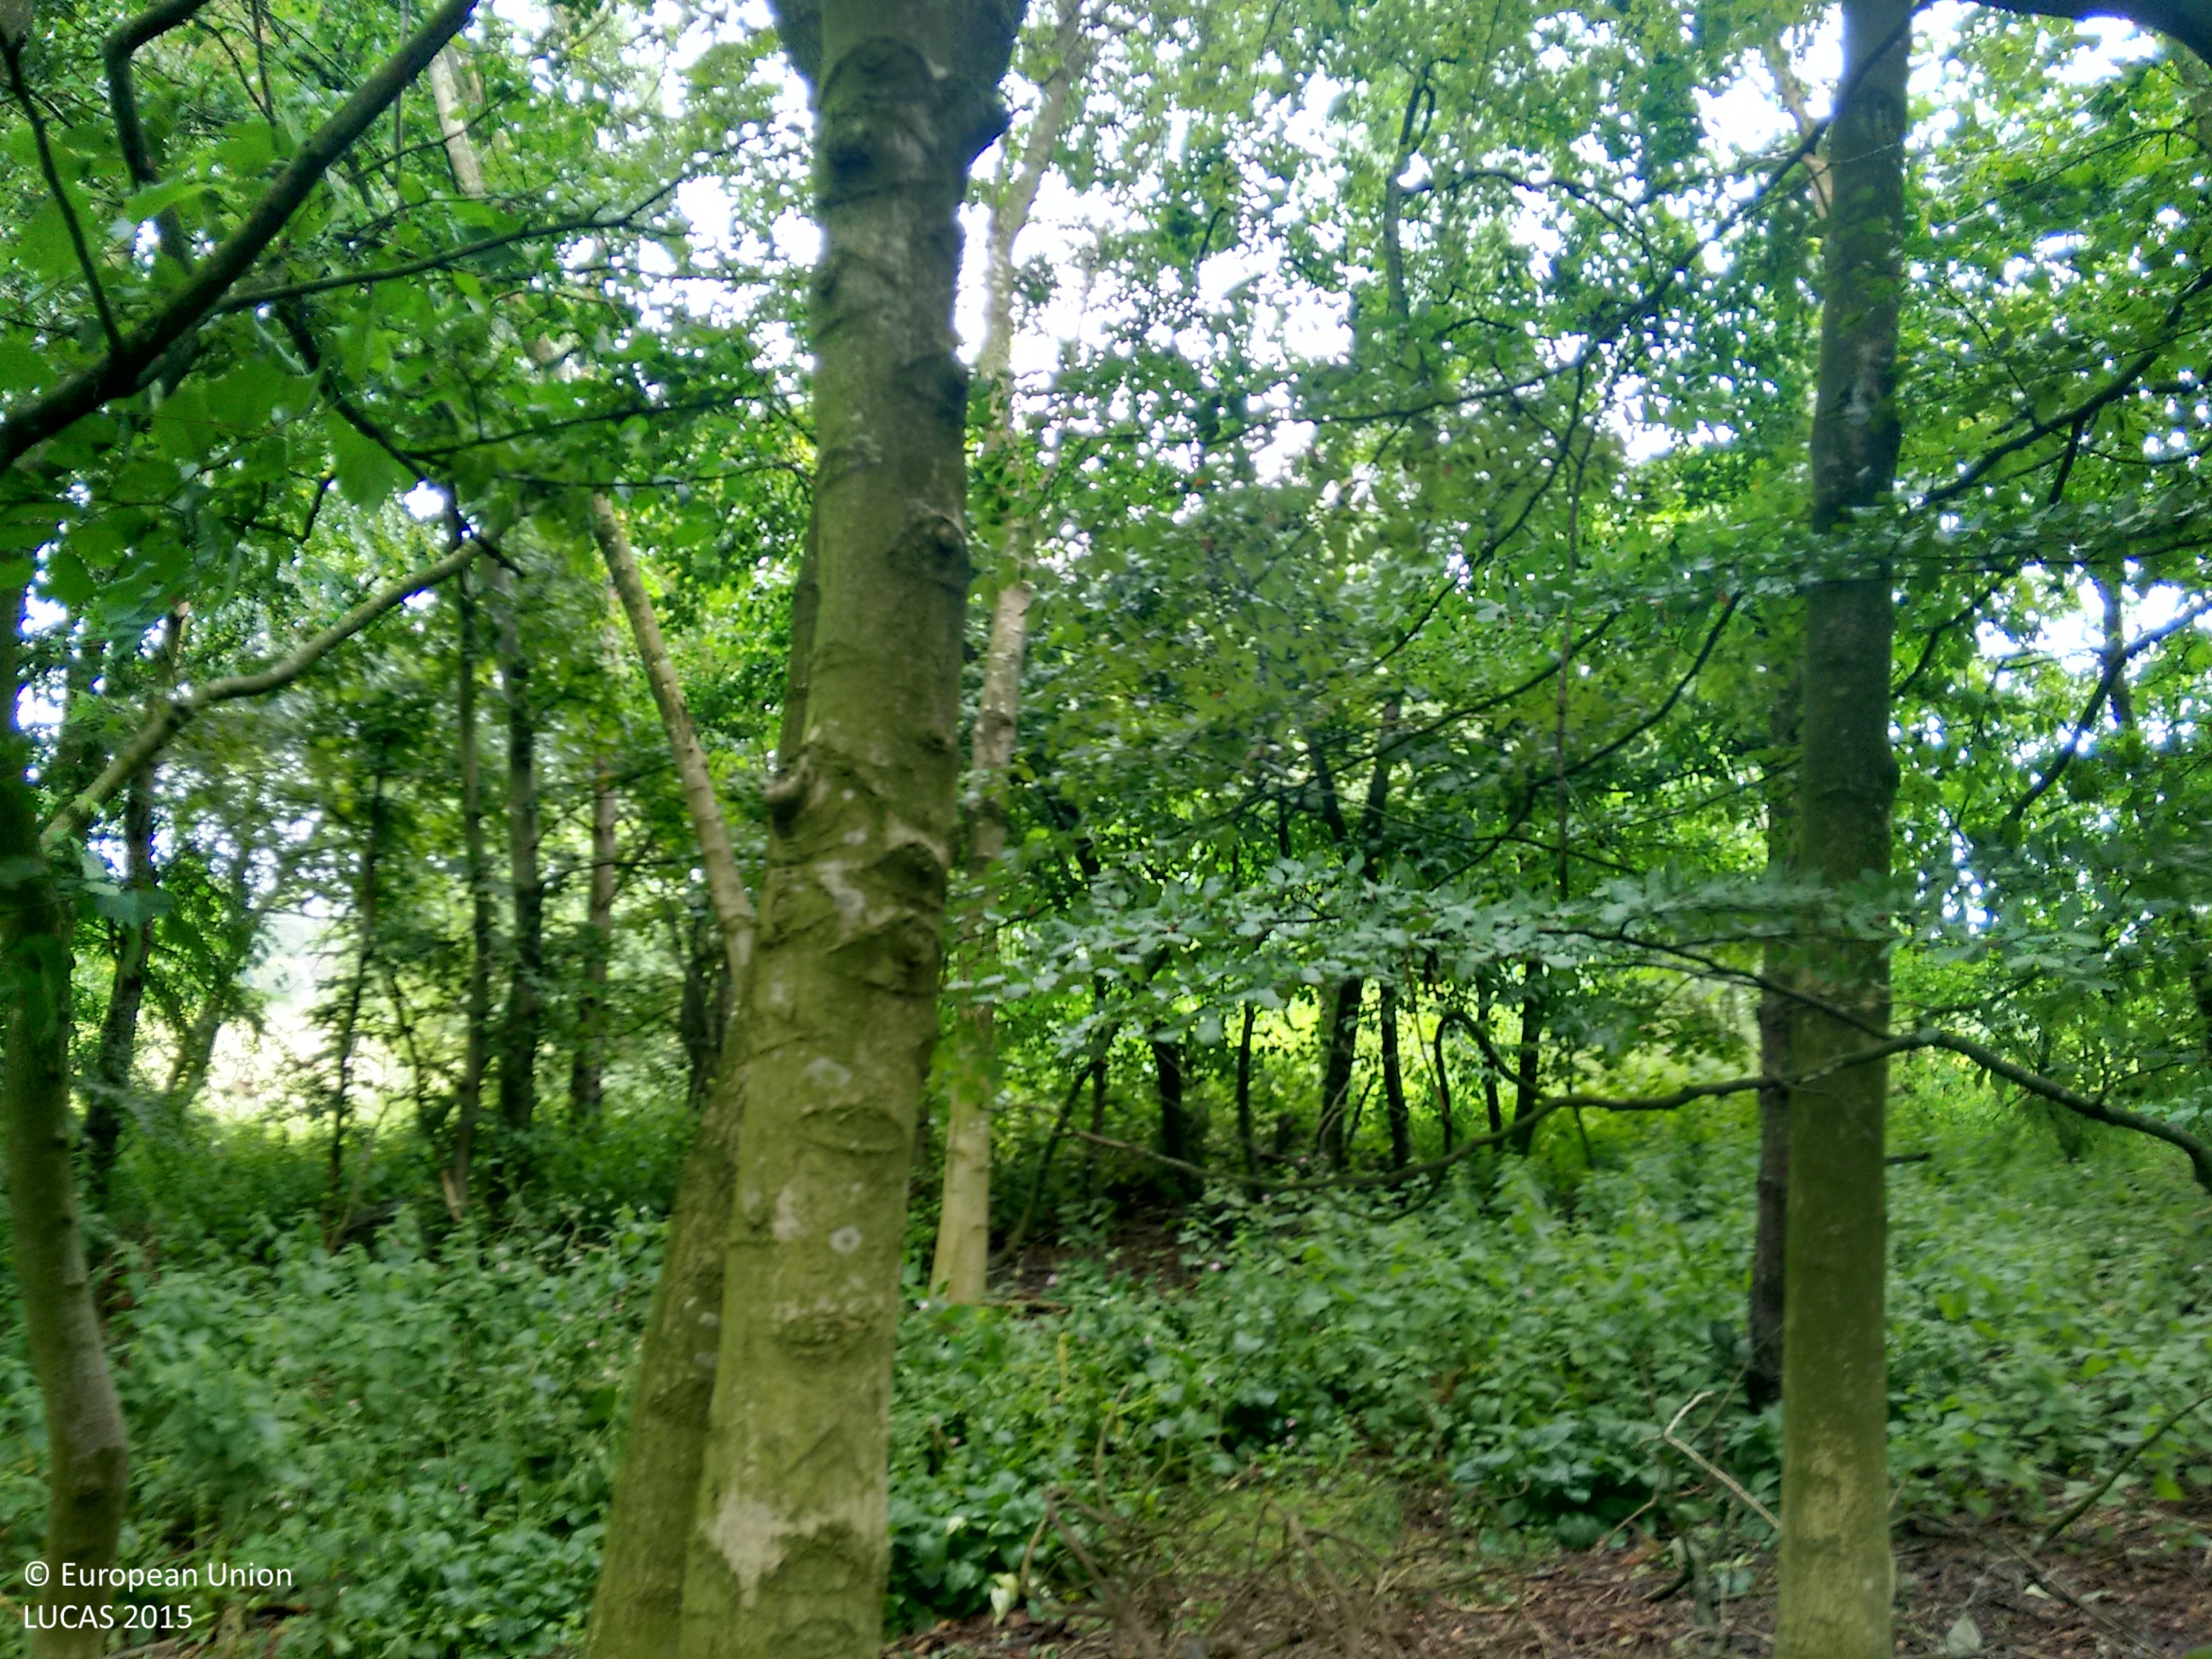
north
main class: Woodland
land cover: Broadleaved woodland
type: beech forest
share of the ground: > 75 %
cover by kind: broadleaved forest trees 100 %
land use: Semi-natural and natural areas not in use
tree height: > 5 m
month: July
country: GB
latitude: 56.4213
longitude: -2.9536
